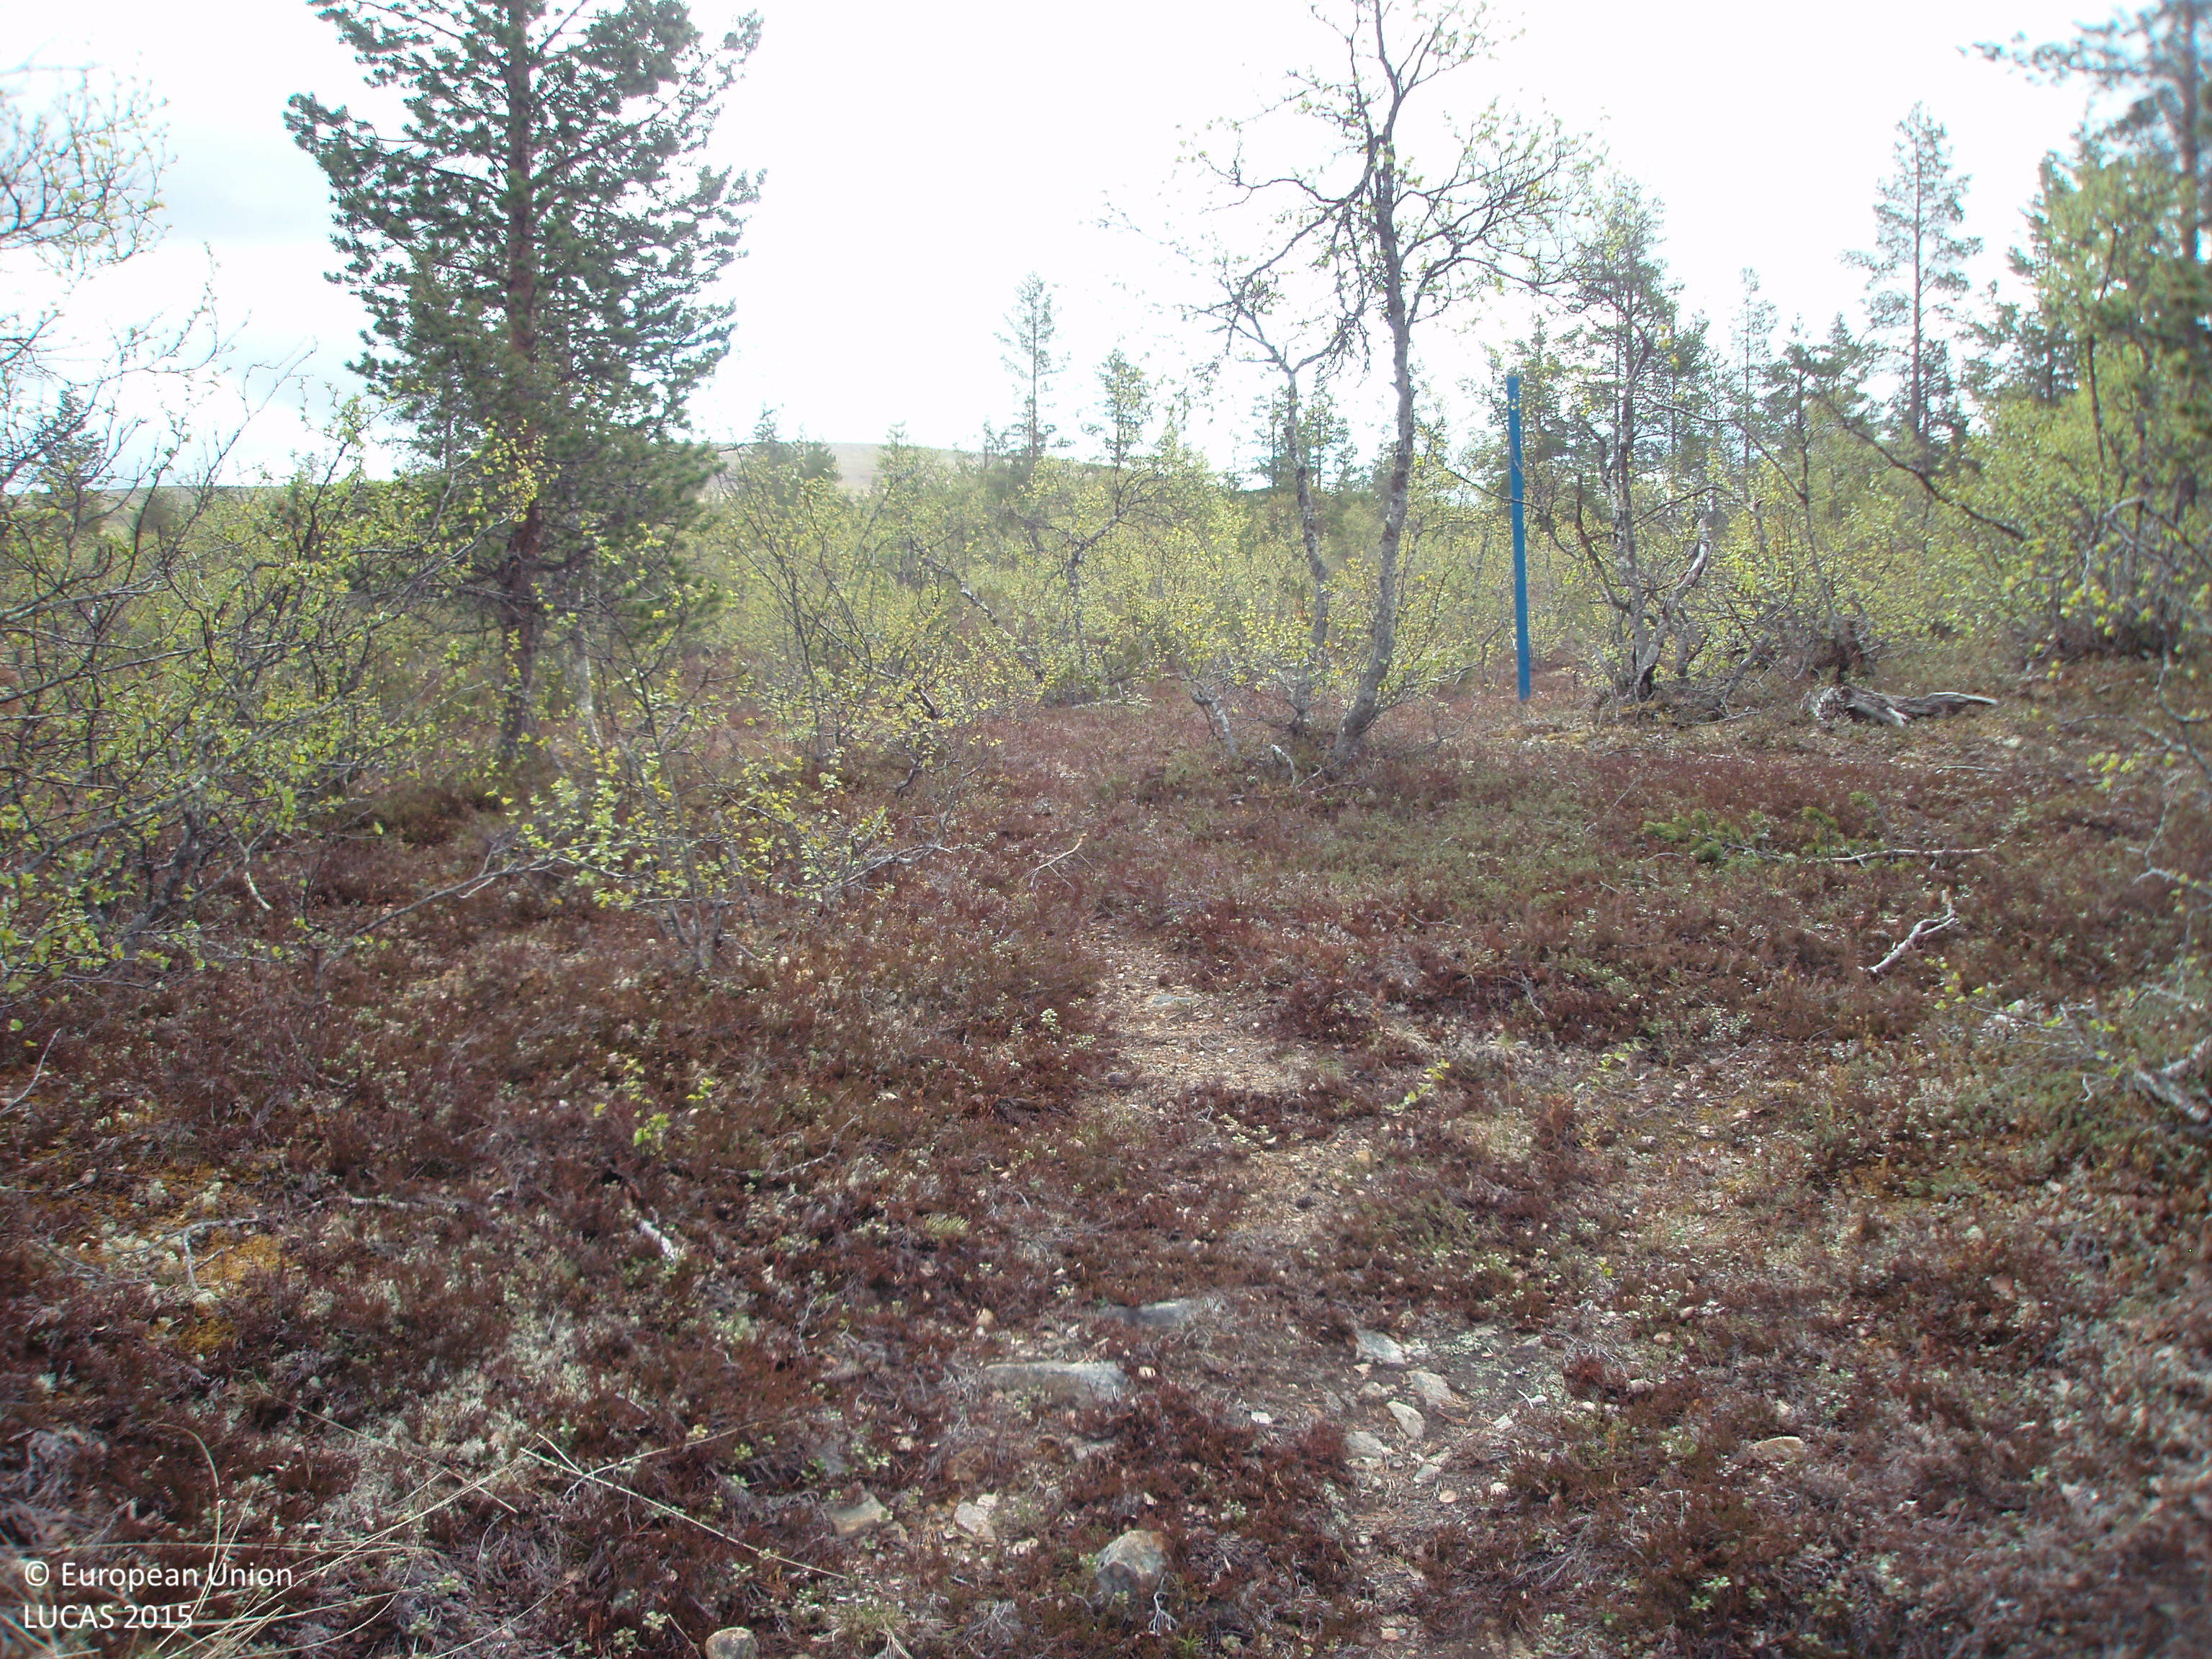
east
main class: Woodland
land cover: Other mixed woodland
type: boreal forest
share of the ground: > 75 %
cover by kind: broadleaved forest trees 55 %, shrubs 25 %, coniferous forest trees 20 %
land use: Amenities, museums, leisure
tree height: > 5 m
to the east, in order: Other mixed woodland
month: June
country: FI
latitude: 68.2093
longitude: 27.6880
